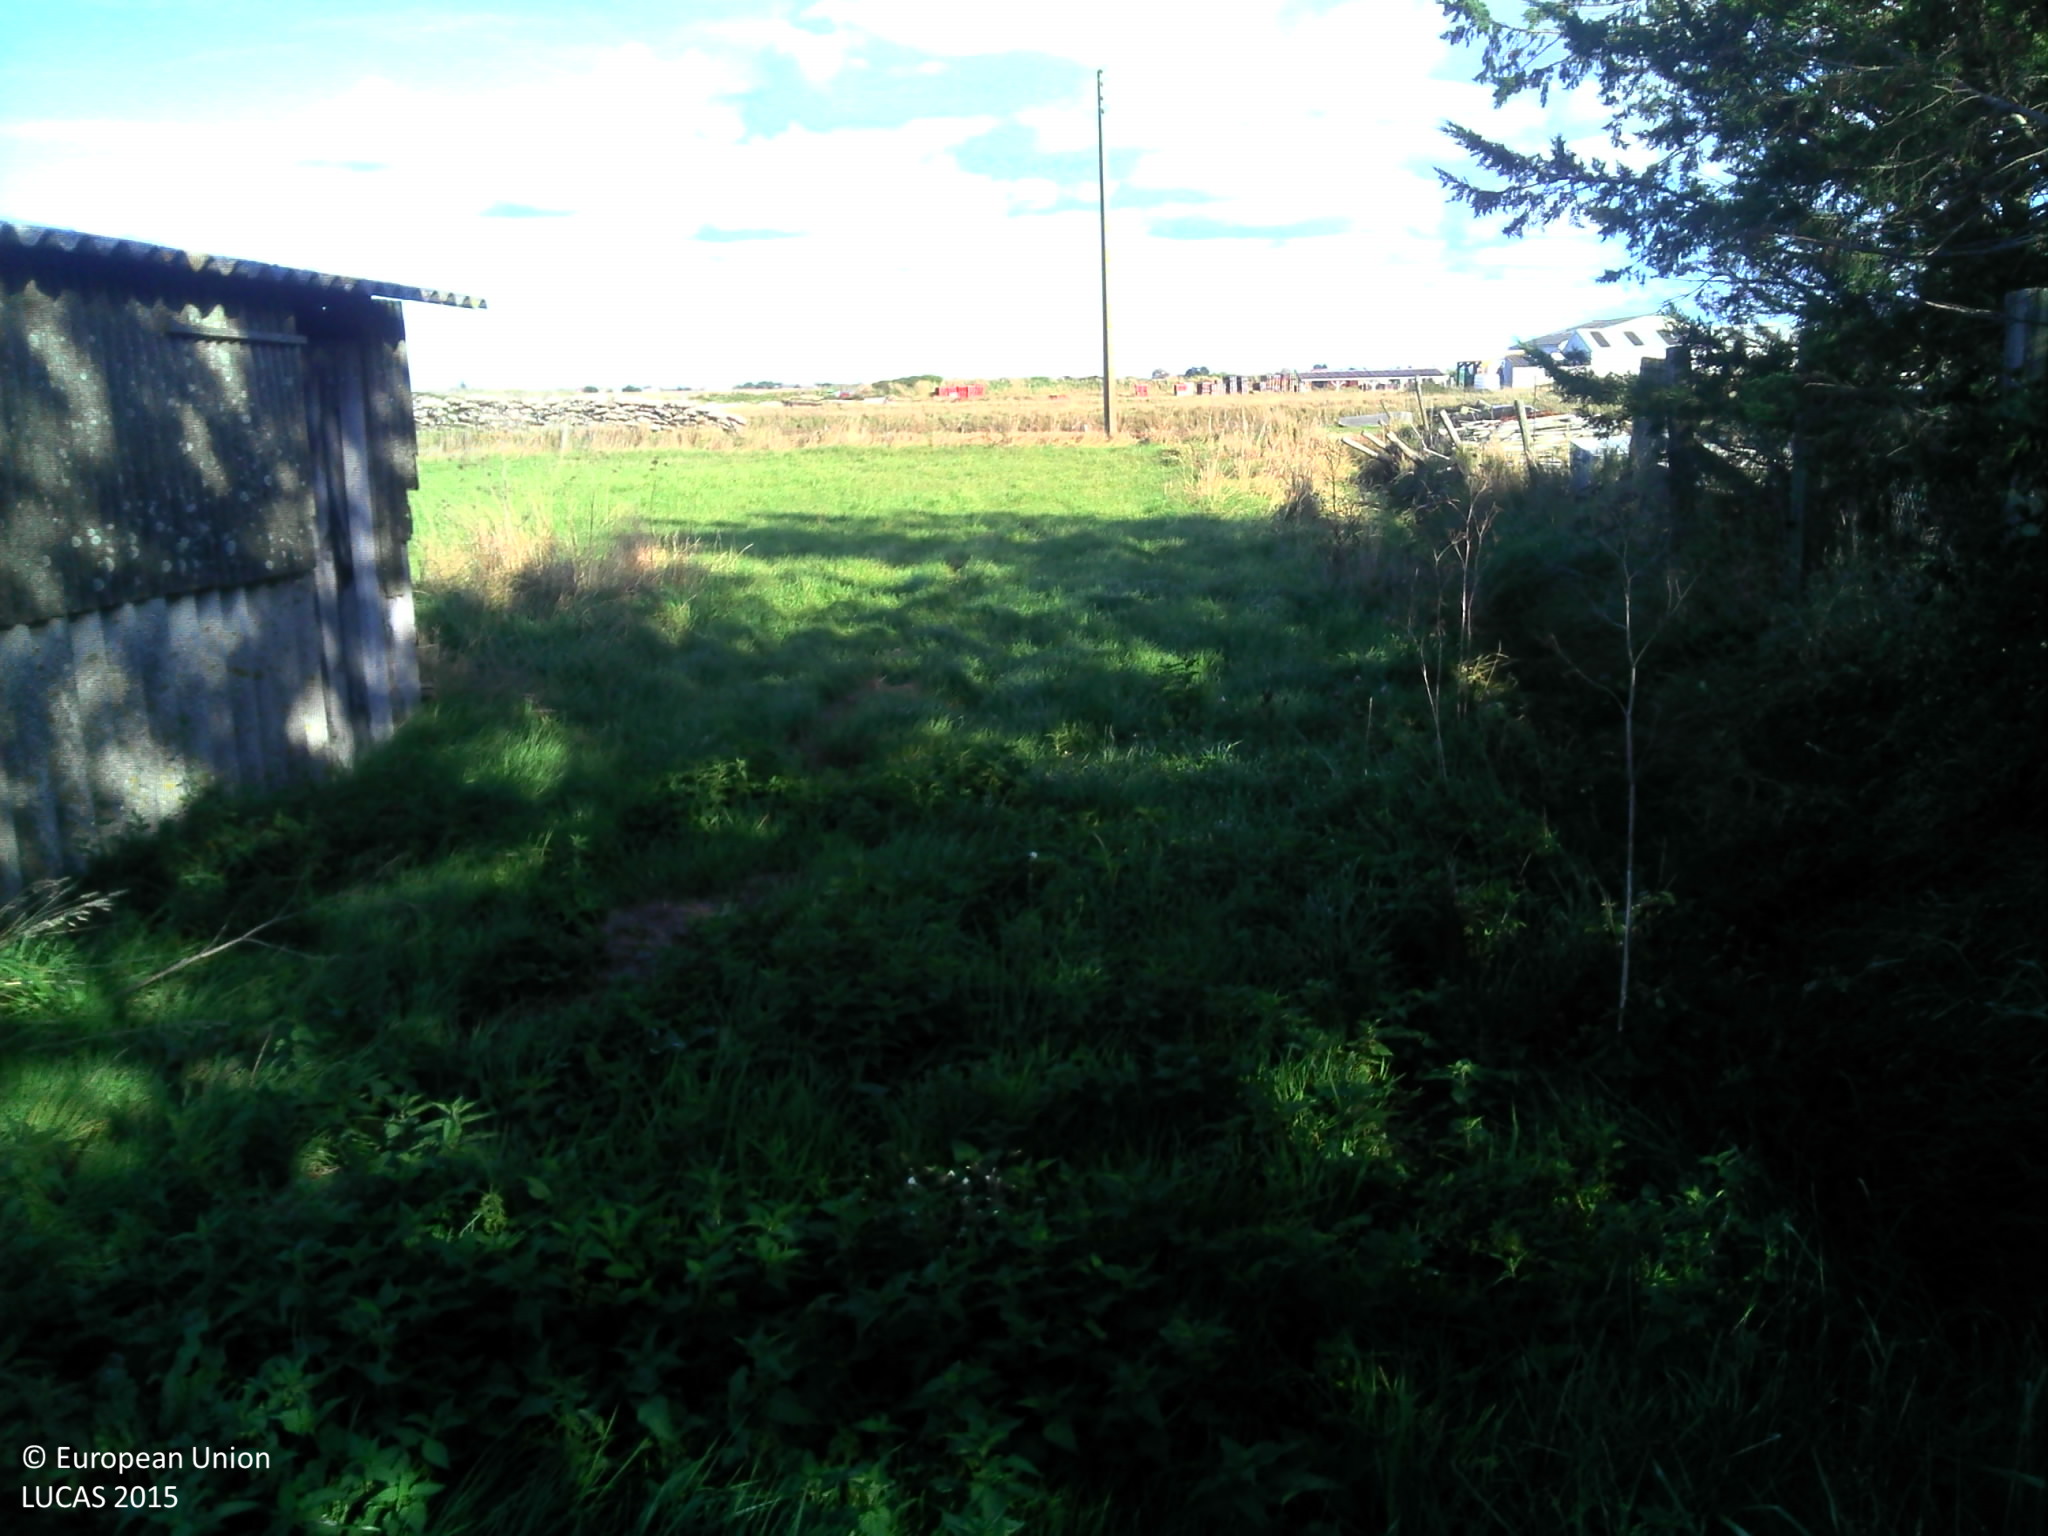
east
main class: Grassland
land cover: Grassland without tree/shrub cover
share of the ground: > 75 %
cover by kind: herbaceous plants 100 %
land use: Agriculture (excluding fallow land and kitchen gardens)
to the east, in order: Grassland without tree/shrub cover; Fences; Ditches and canals; Grass margins; Electric lines; Tracks; Ditches and canals; Spontaneously vegetated surfaces; Inland fresh water bodies; Spontaneously vegetated surfaces; Inland fresh running water; Grassland without tree/shrub cover; Inland fresh water bodies; Grassland without tree/shrub cover; Inland fresh running water; Spontaneously vegetated surfaces; Inland fresh running water; Tracks; Inland fresh water bodies; Tracks
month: September
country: FR
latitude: 46.9983
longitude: -2.0277
